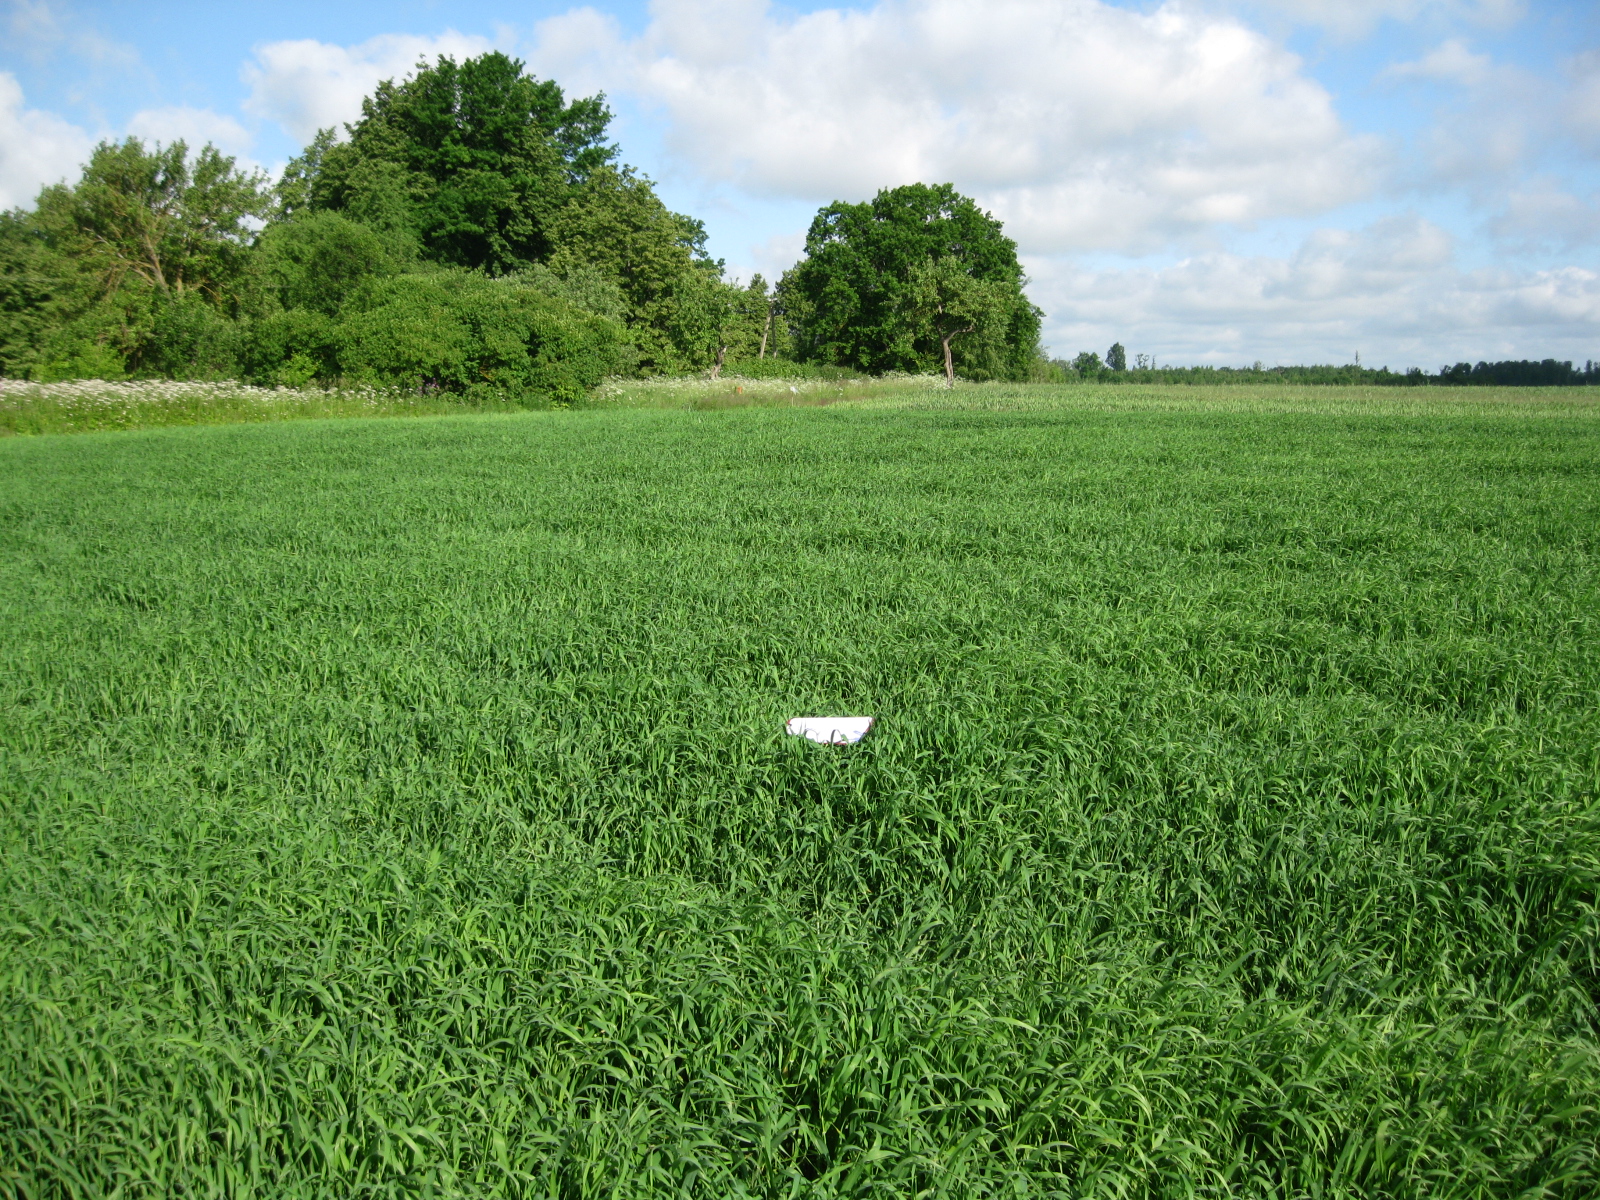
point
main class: Cropland
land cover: Barley
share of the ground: > 75 %
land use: Agriculture (excluding fallow land and kitchen gardens)
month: June
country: LT
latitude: 55.1921
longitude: 23.7031
